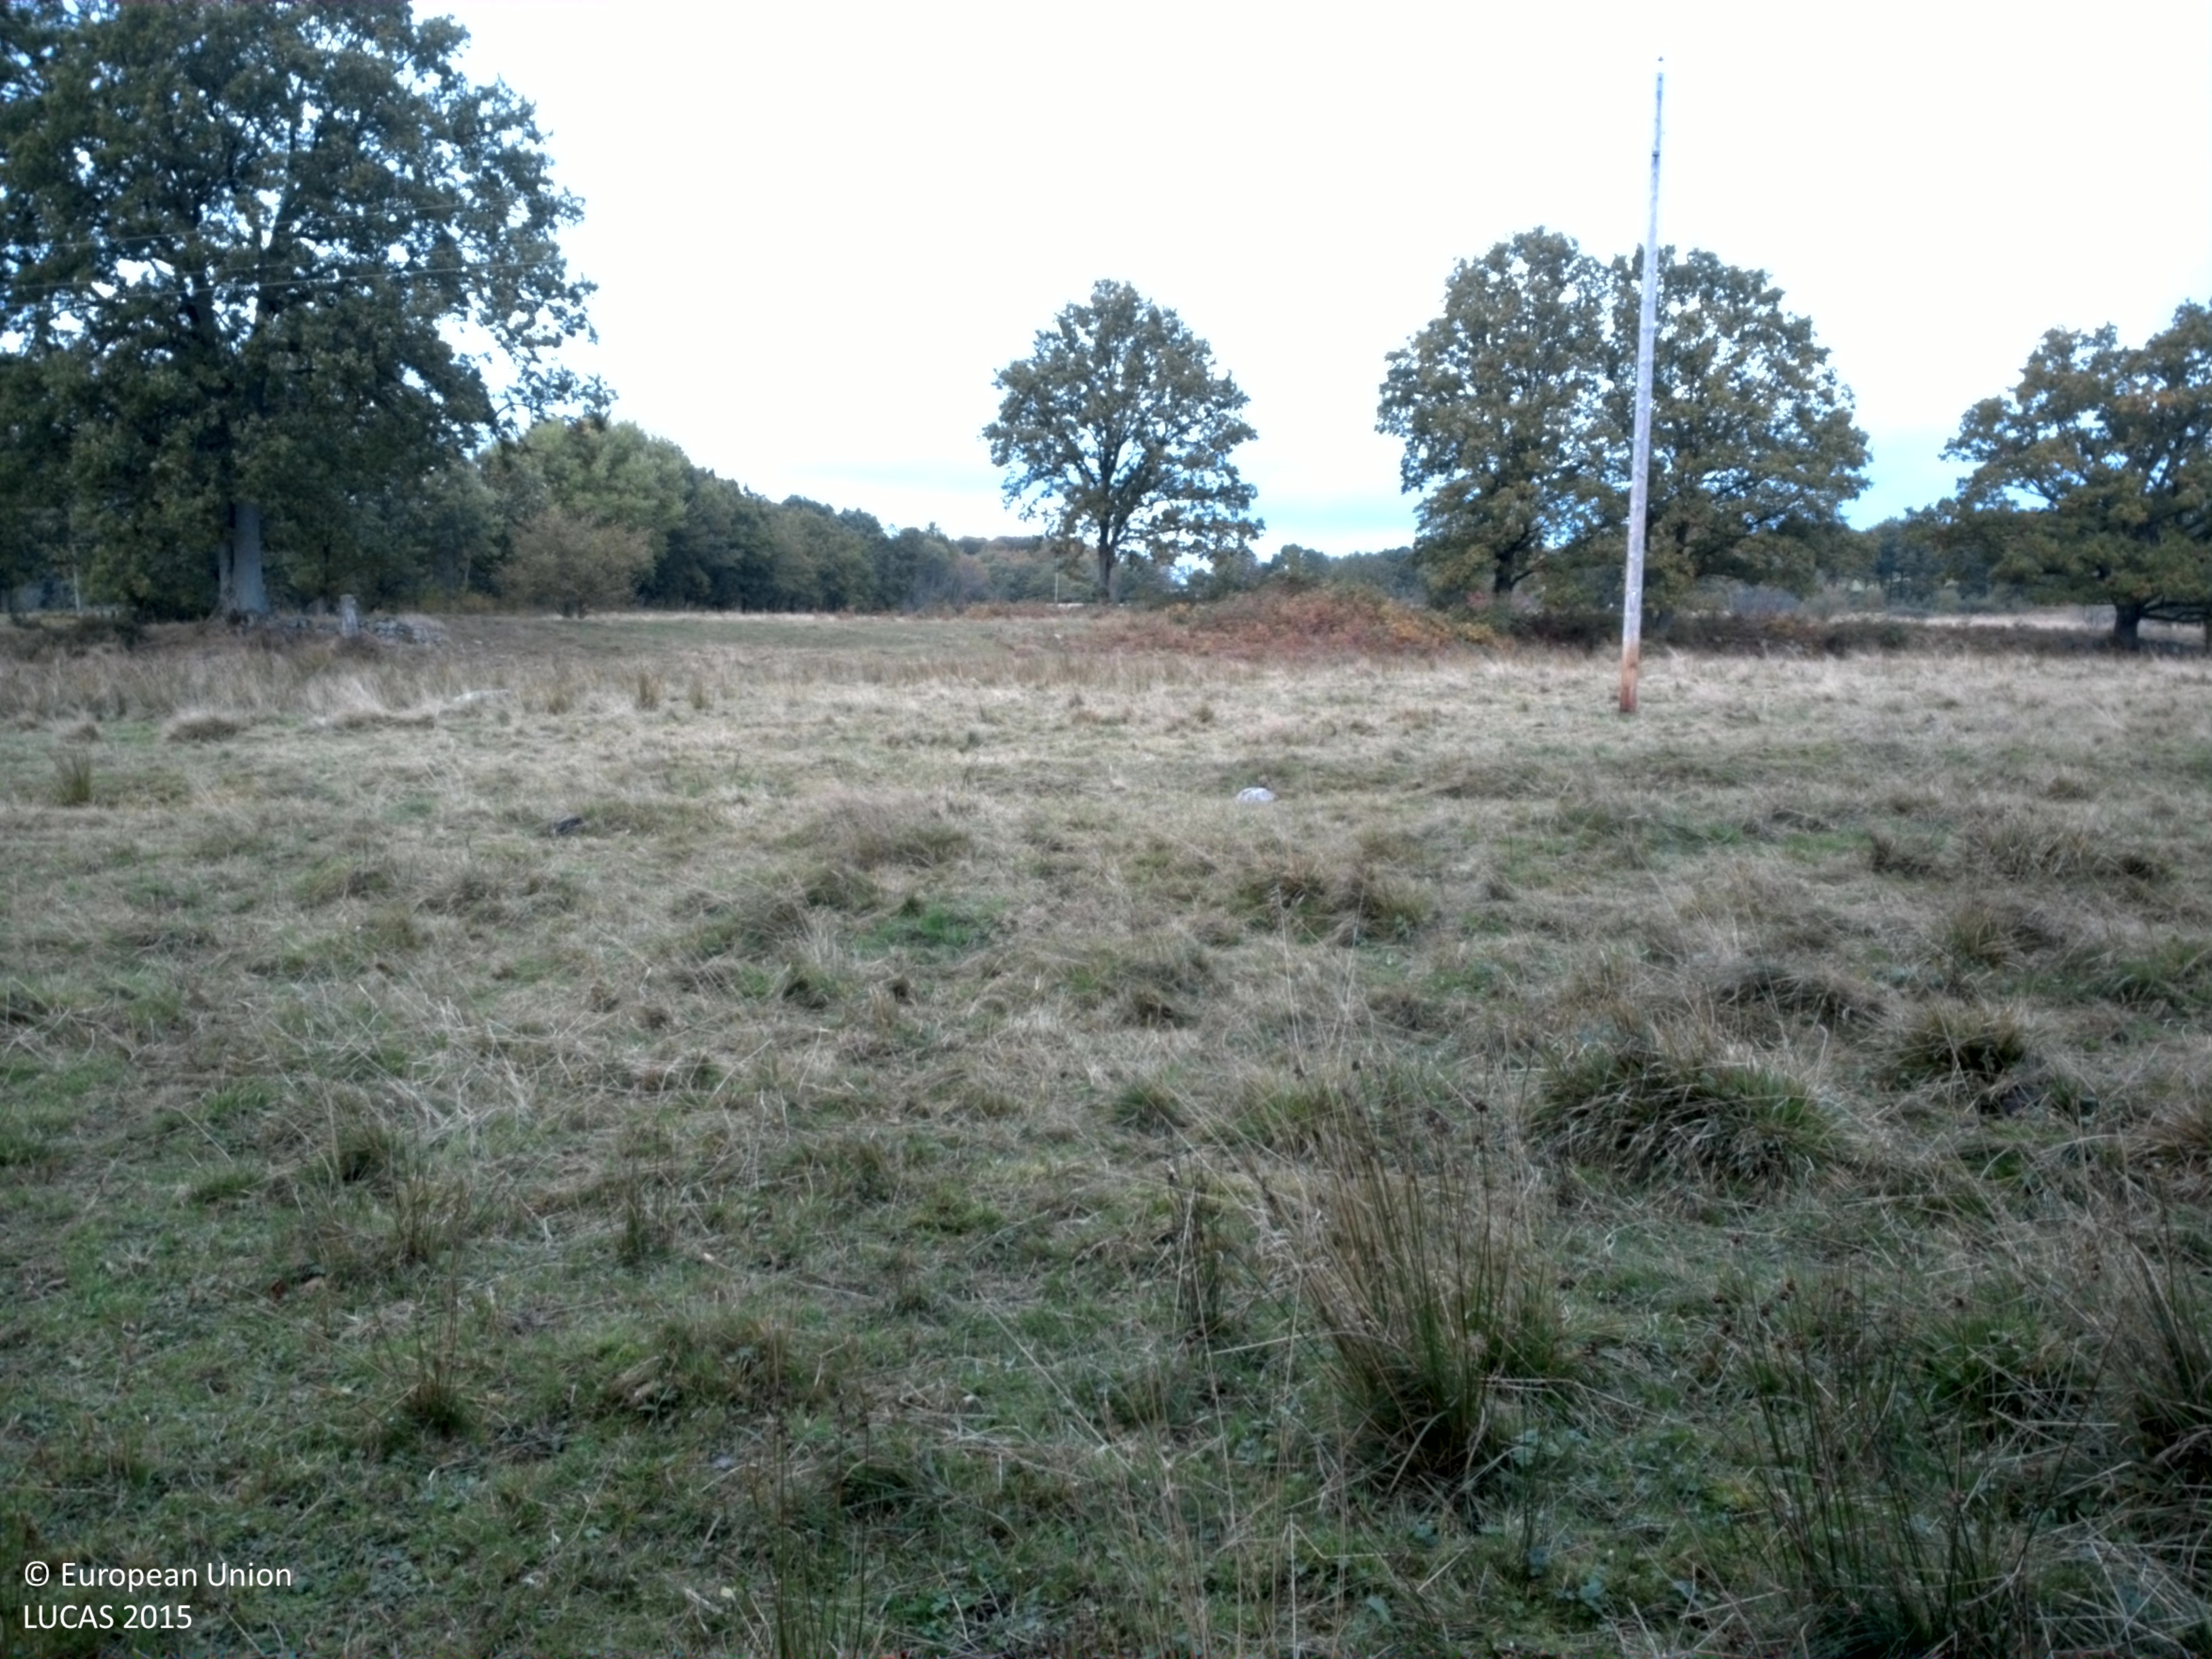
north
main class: Grassland
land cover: Grassland without tree/shrub cover
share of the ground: > 75 %
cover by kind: herbaceous plants 100 %
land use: Agriculture (excluding fallow land and kitchen gardens)
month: October
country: SE
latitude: 55.6918
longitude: 14.0549
